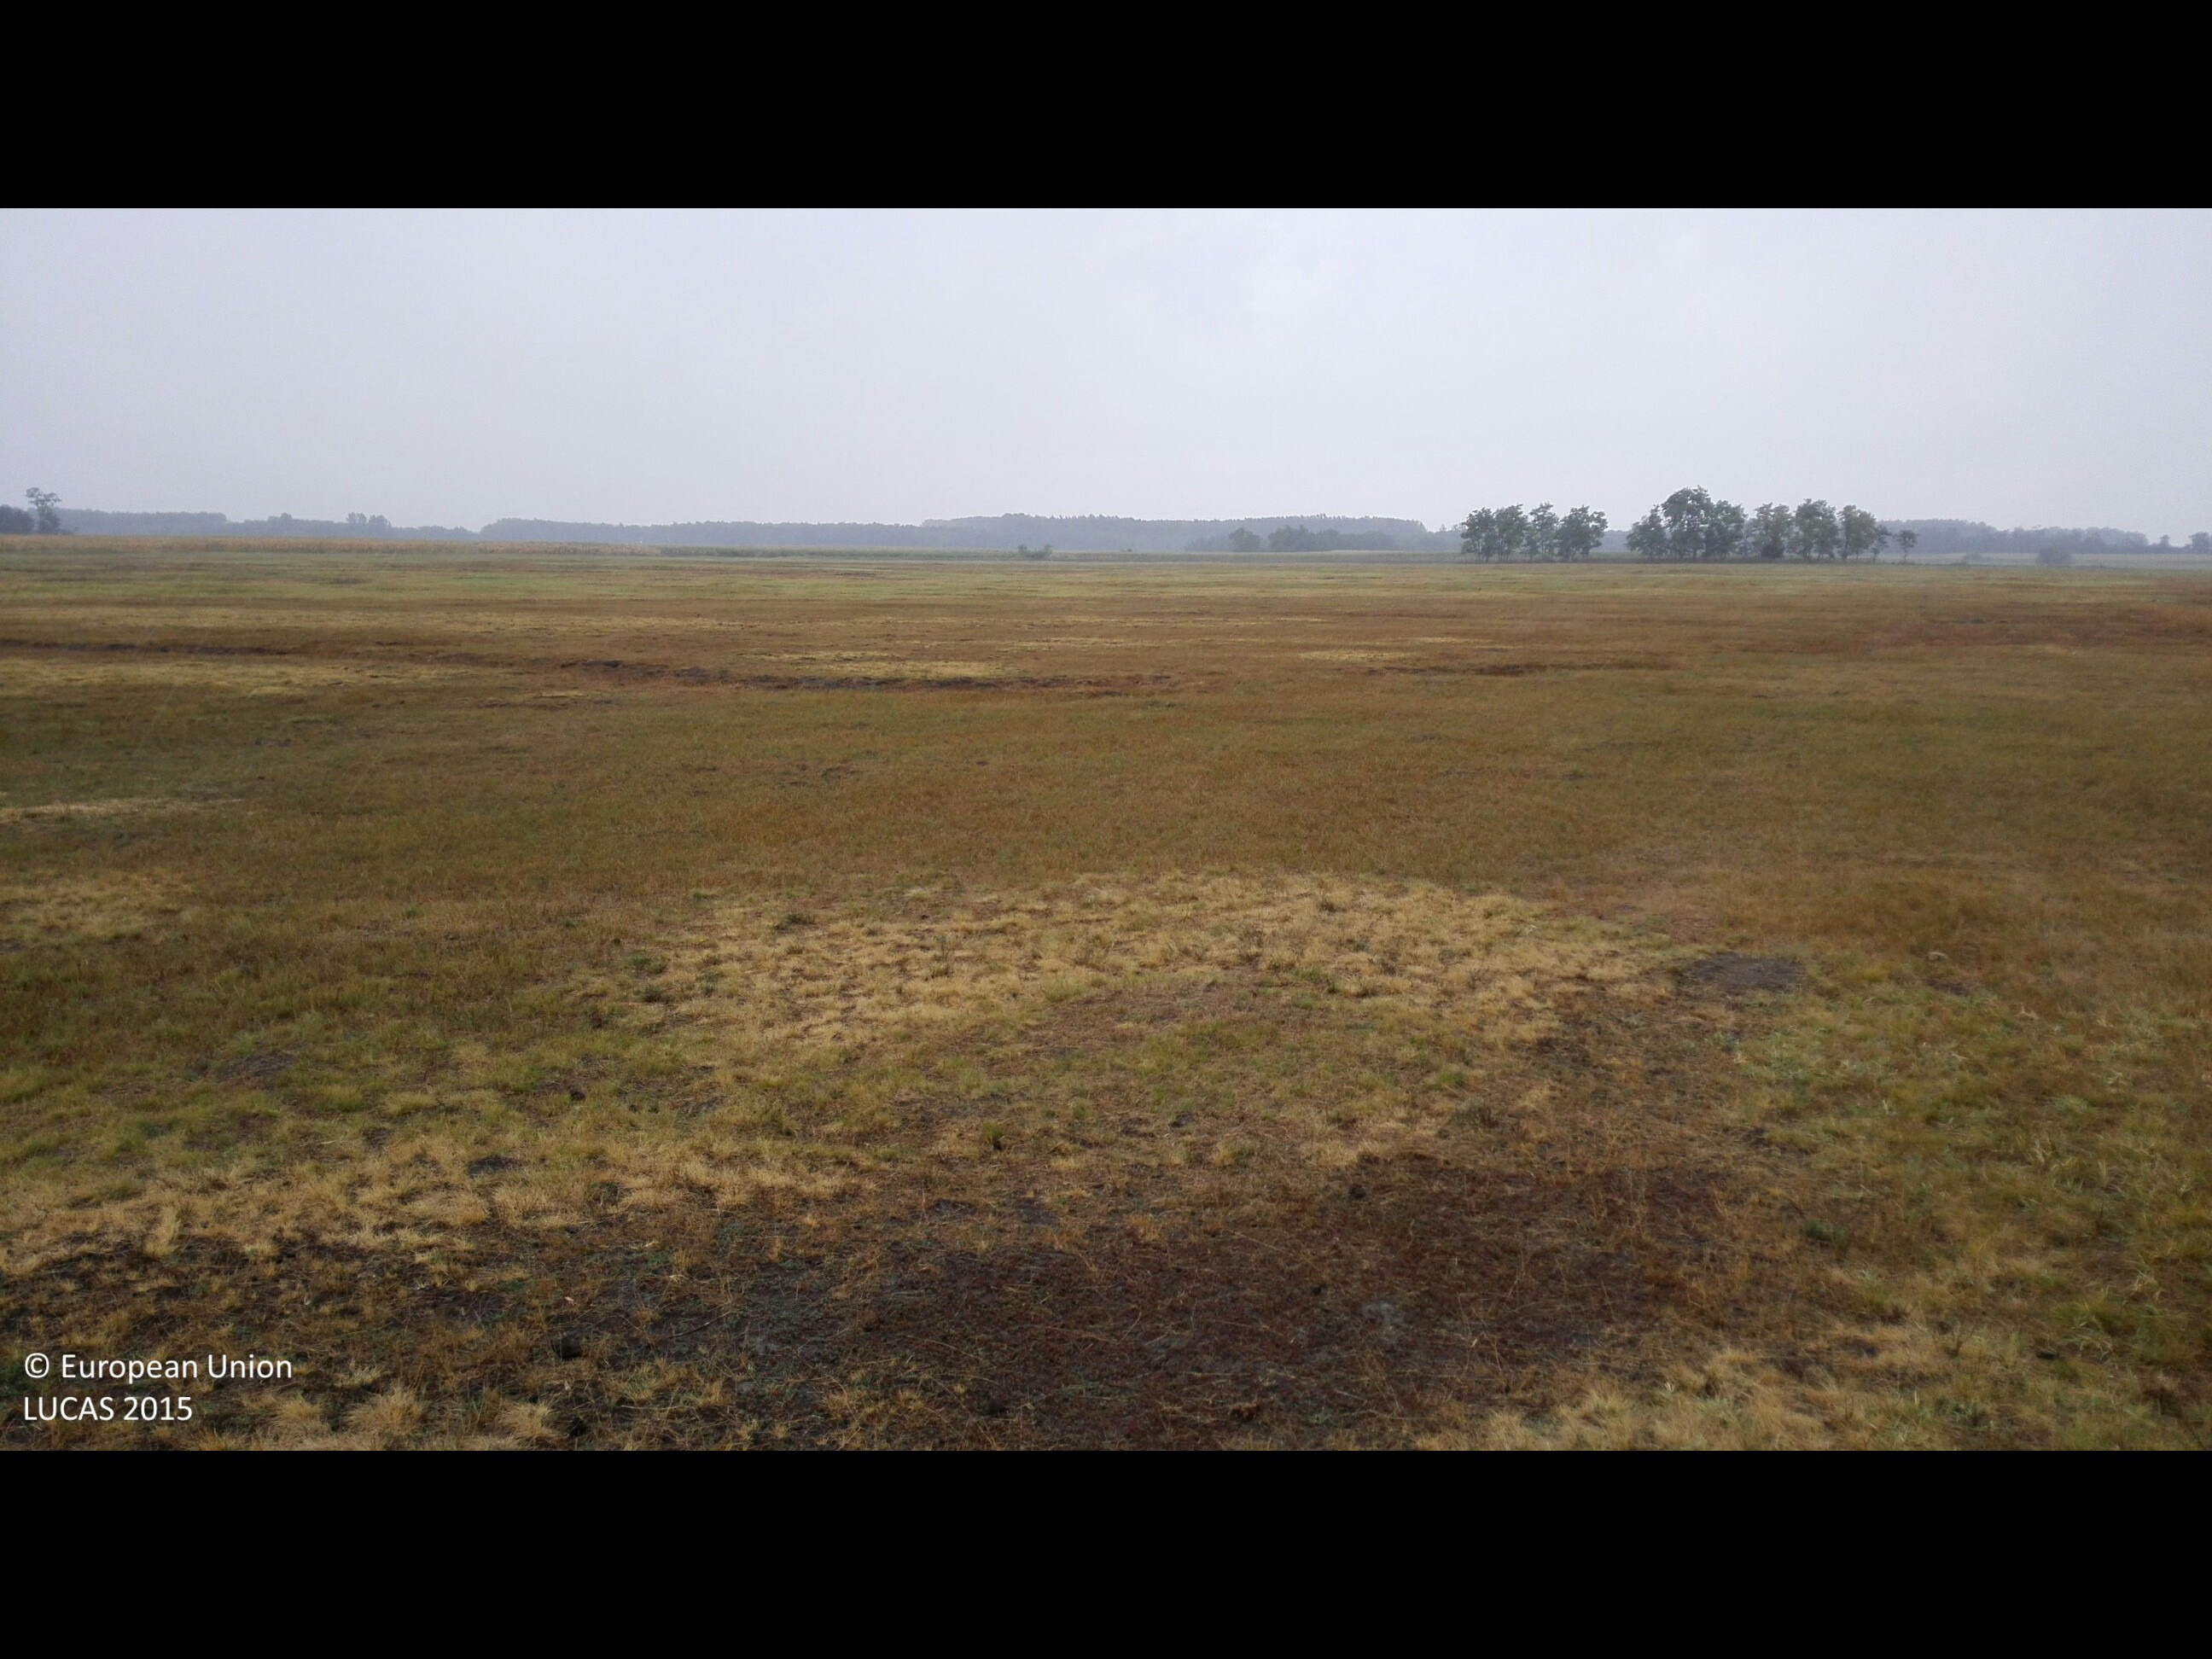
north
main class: Grassland
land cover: Grassland without tree/shrub cover
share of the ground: > 75 %
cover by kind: herbaceous plants 100 %
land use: Agriculture (excluding fallow land and kitchen gardens)
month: August
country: HU
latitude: 47.3458
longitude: 21.6794
